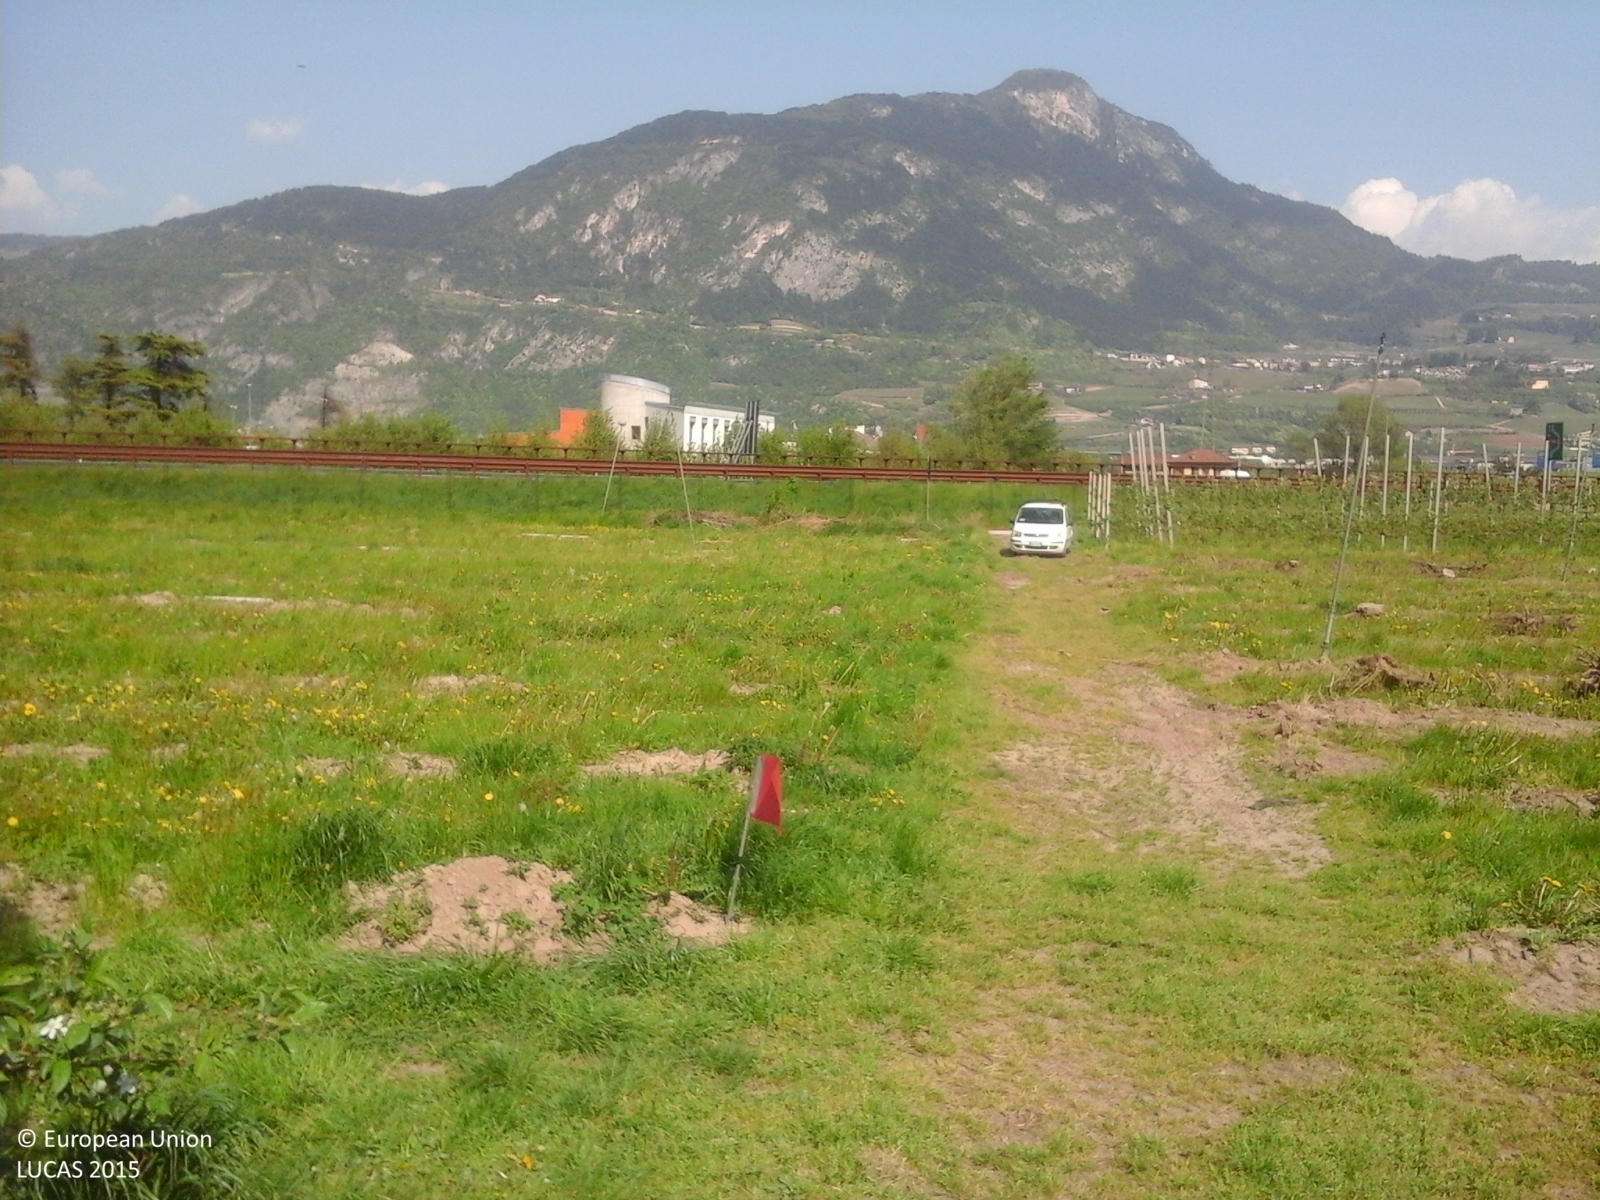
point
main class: Grassland
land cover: Spontaneously vegetated surfaces
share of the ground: > 75 %
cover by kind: herbaceous plants 90 %, unconsolidated bare surface 10 %
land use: Fallow land
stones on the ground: < 10 %
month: April
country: IT
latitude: 46.0934
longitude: 11.0978
